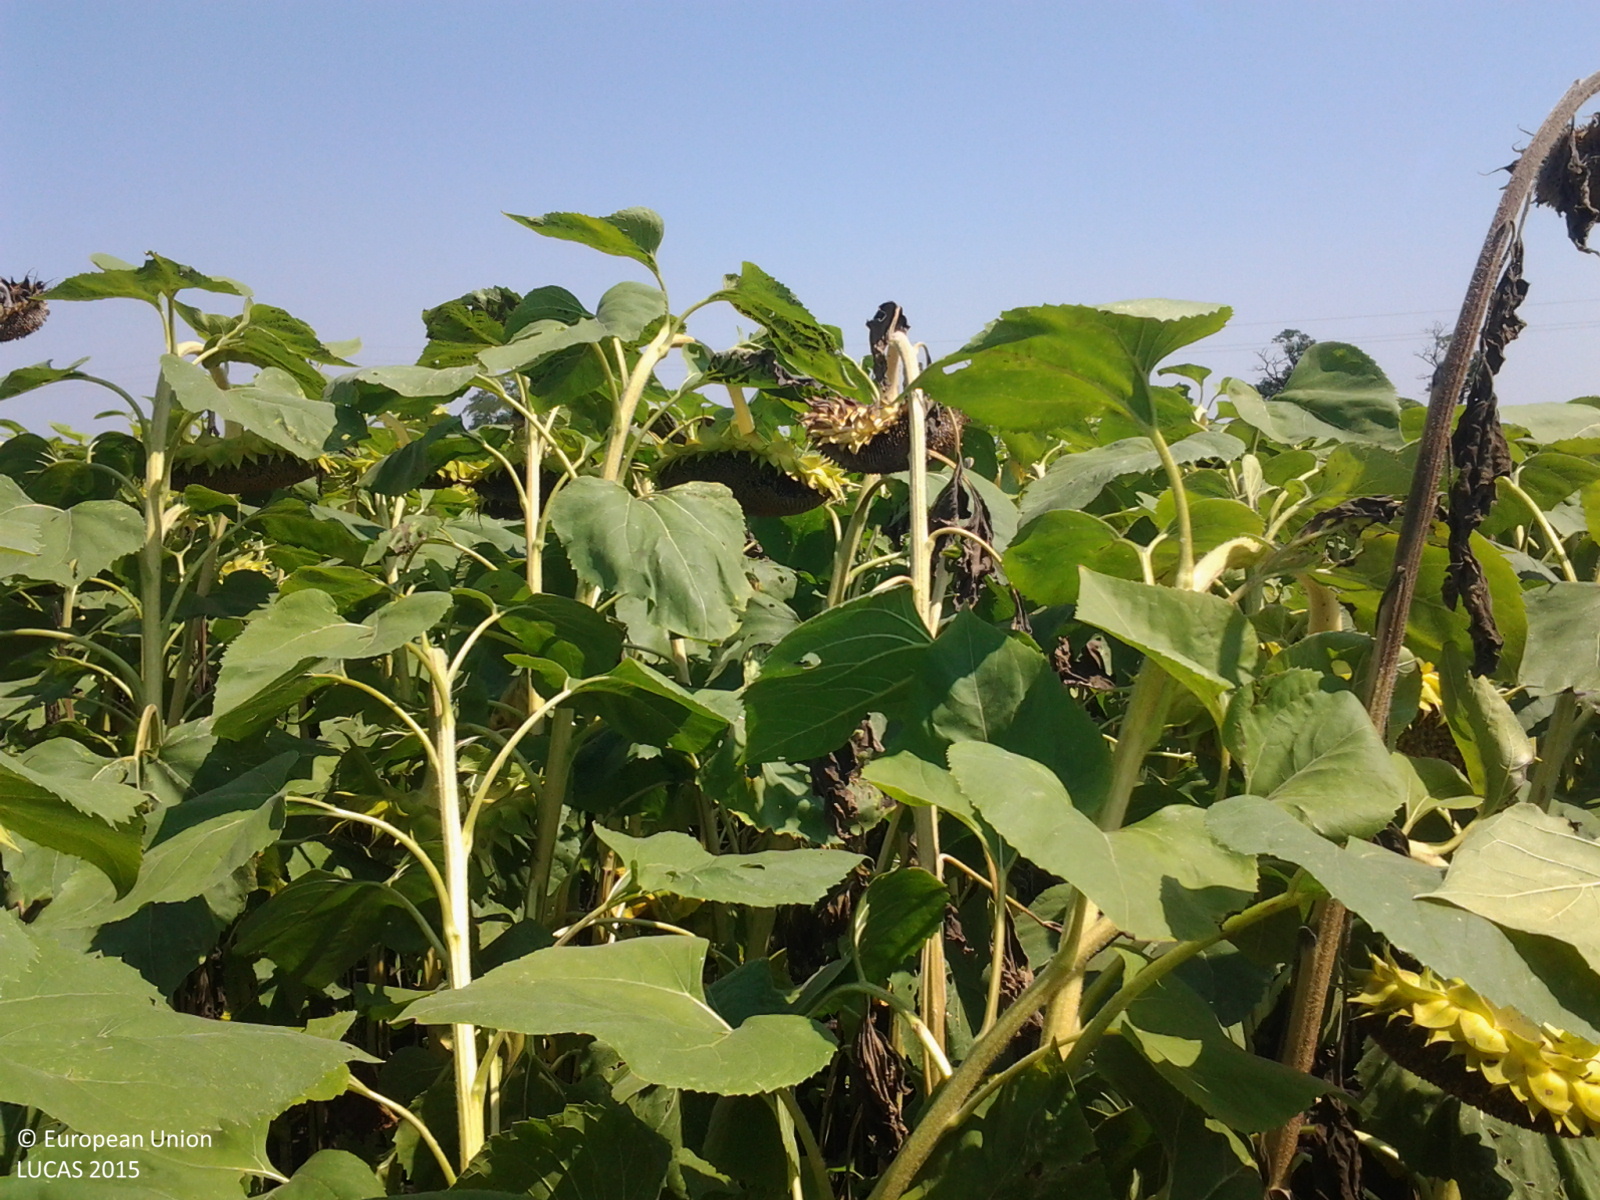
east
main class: Cropland
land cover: Sunflower
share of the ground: > 75 %
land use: Agriculture (excluding fallow land and kitchen gardens)
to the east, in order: Sunflower; Electric lines; Sunflower; Spontaneously vegetated surfaces; Lines of trees; Shrubland without tree cover; Paved roads, cycling and walking lanes; Grassland without tree/shrub cover; Shruby margins; Sunflower
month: August
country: HU
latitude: 47.2386
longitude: 19.8384
